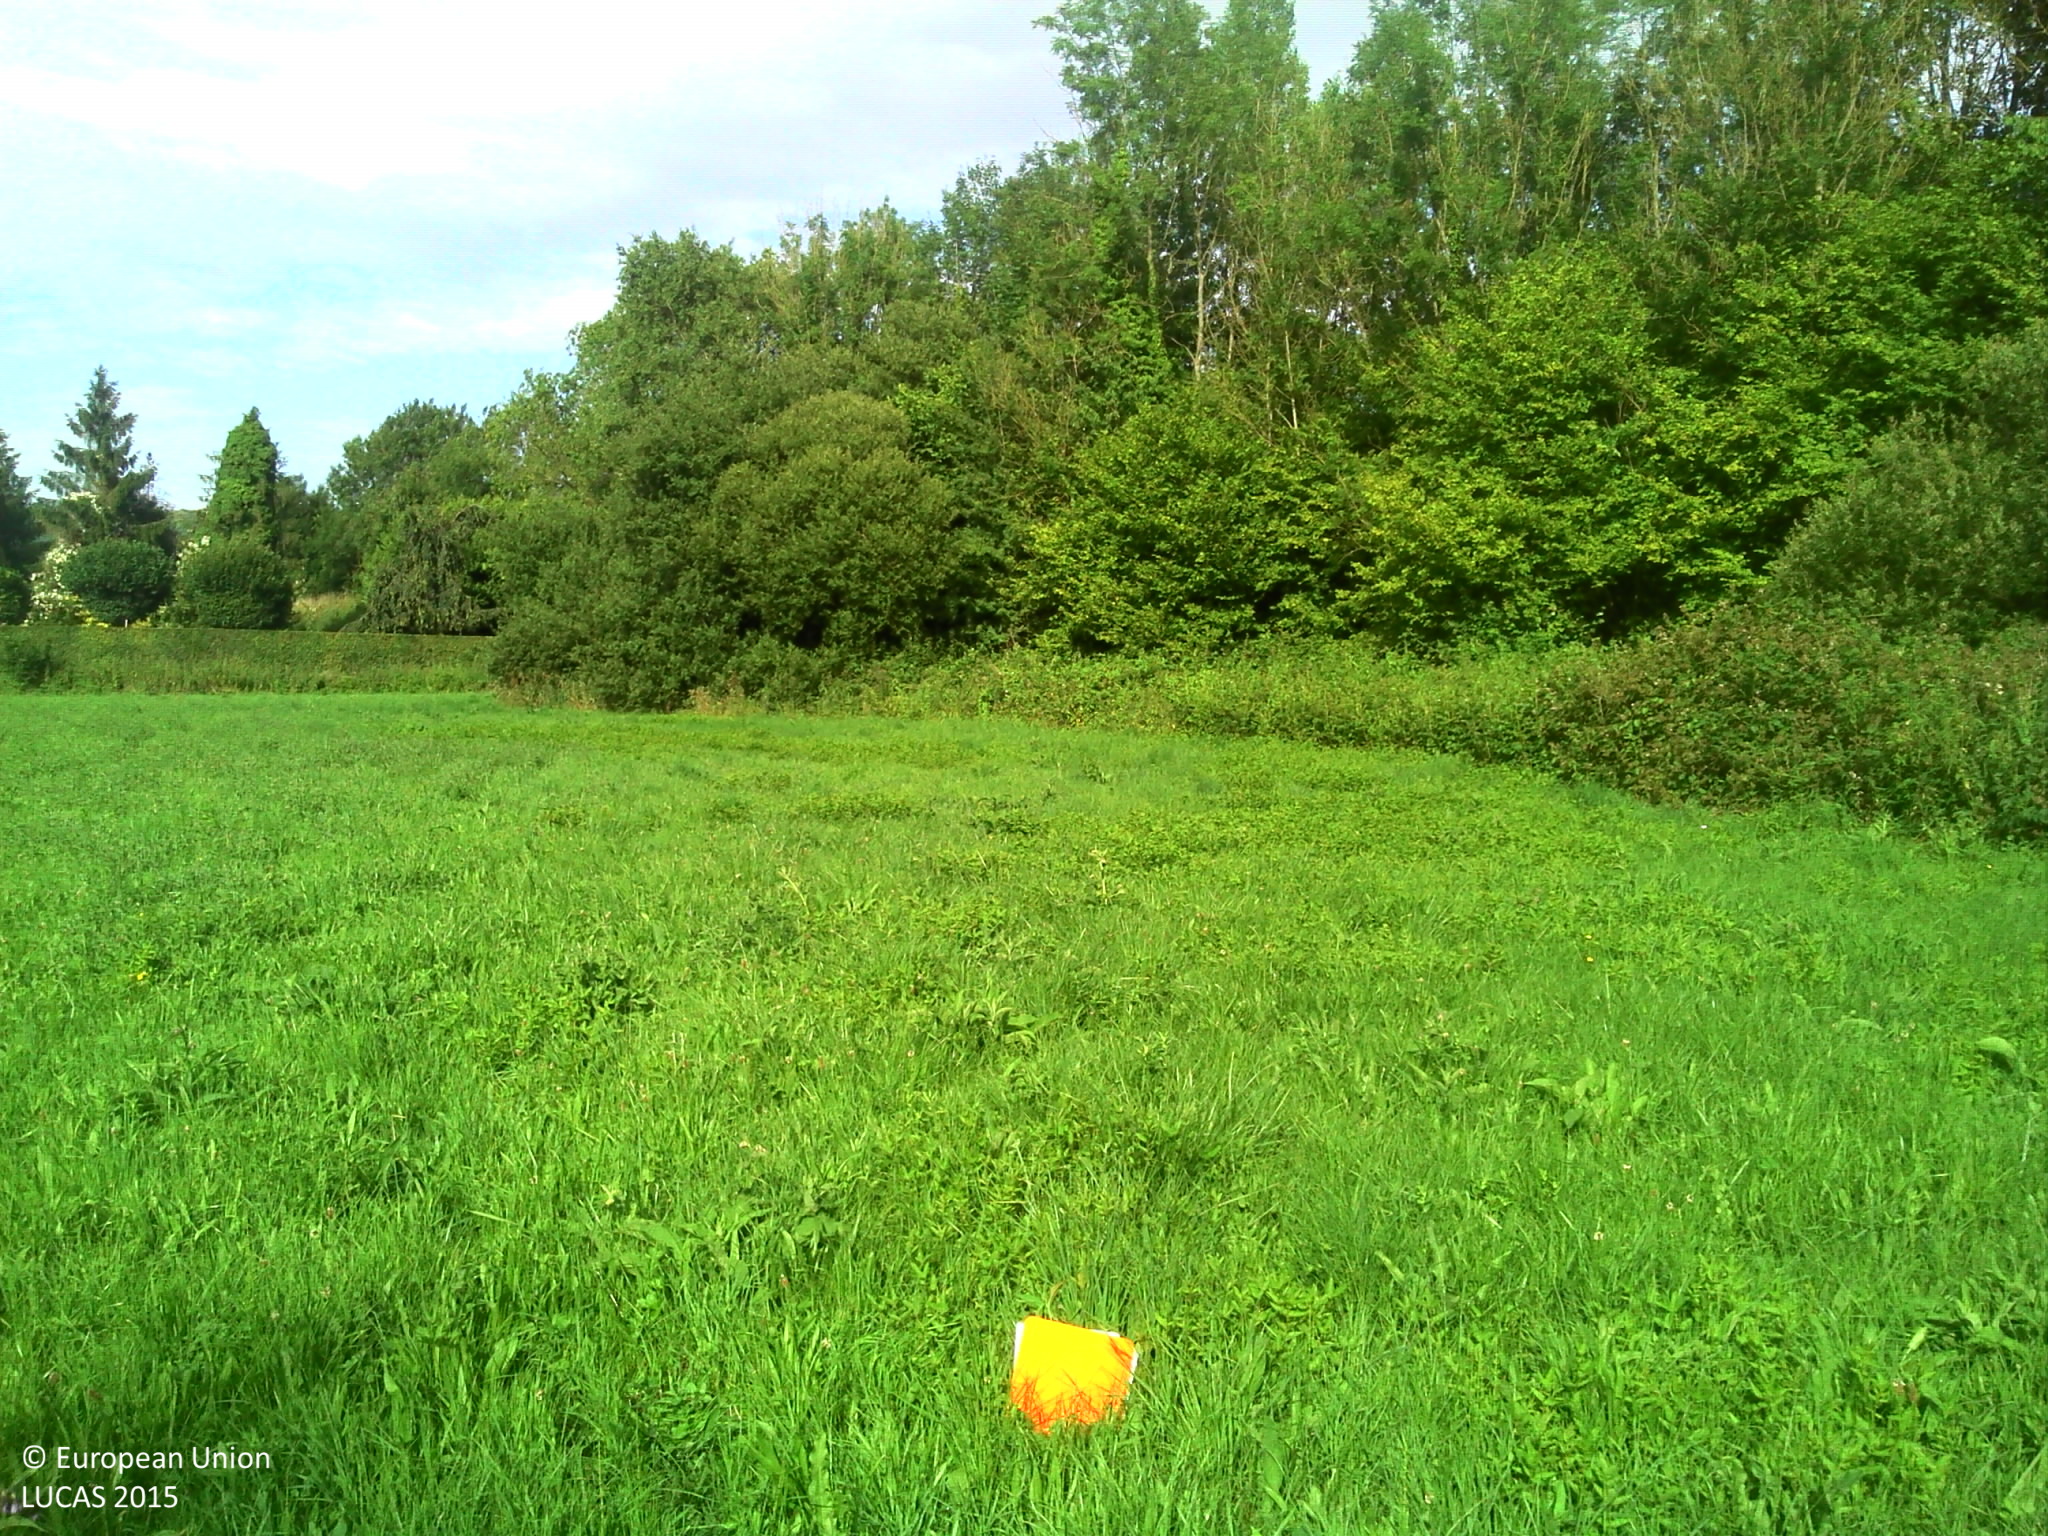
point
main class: Grassland
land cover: Grassland without tree/shrub cover
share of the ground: > 75 %
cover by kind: herbaceous plants 100 %
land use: Agriculture (excluding fallow land and kitchen gardens)
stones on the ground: < 10 %
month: July
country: FR
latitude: 49.3999
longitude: 0.4233
